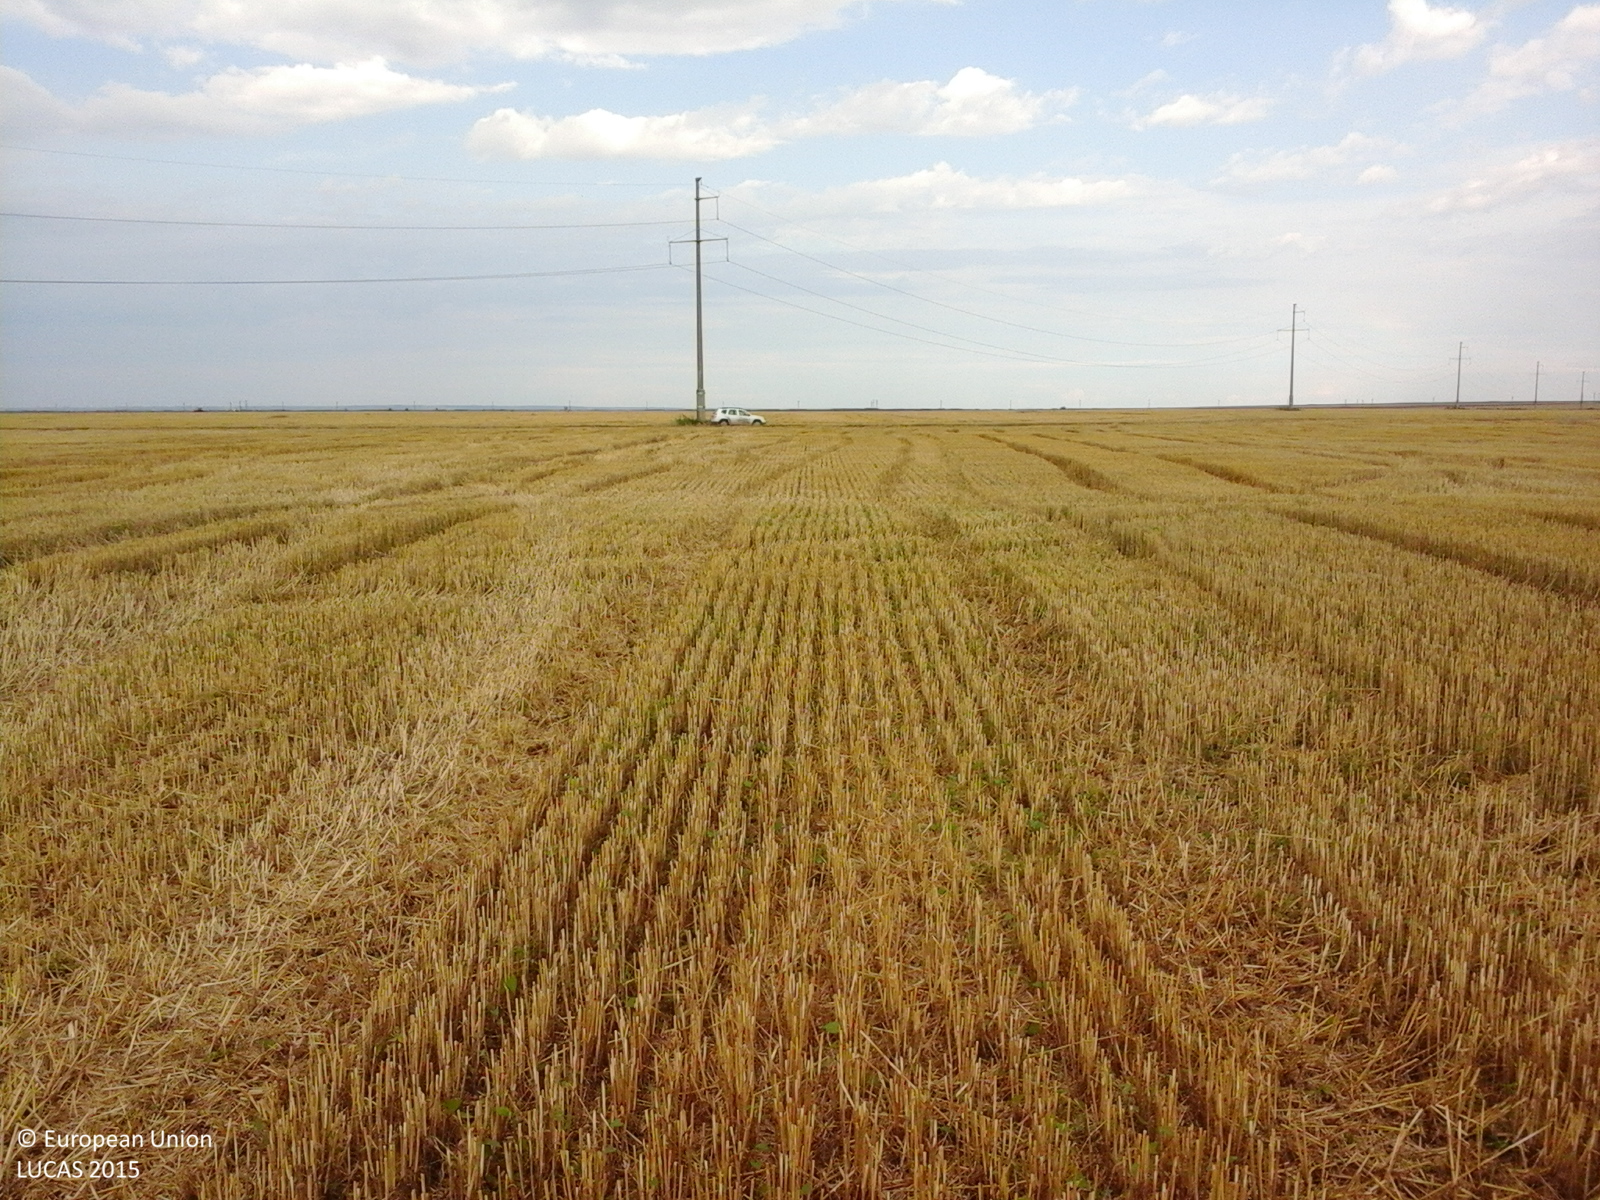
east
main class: Cropland
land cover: Common wheat
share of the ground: < 10 %
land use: Agriculture (excluding fallow land and kitchen gardens)
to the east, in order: Common wheat; Electric lines; Common wheat; Grass margins; Tracks; Common wheat
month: July
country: RO
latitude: 43.8941
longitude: 24.4934
